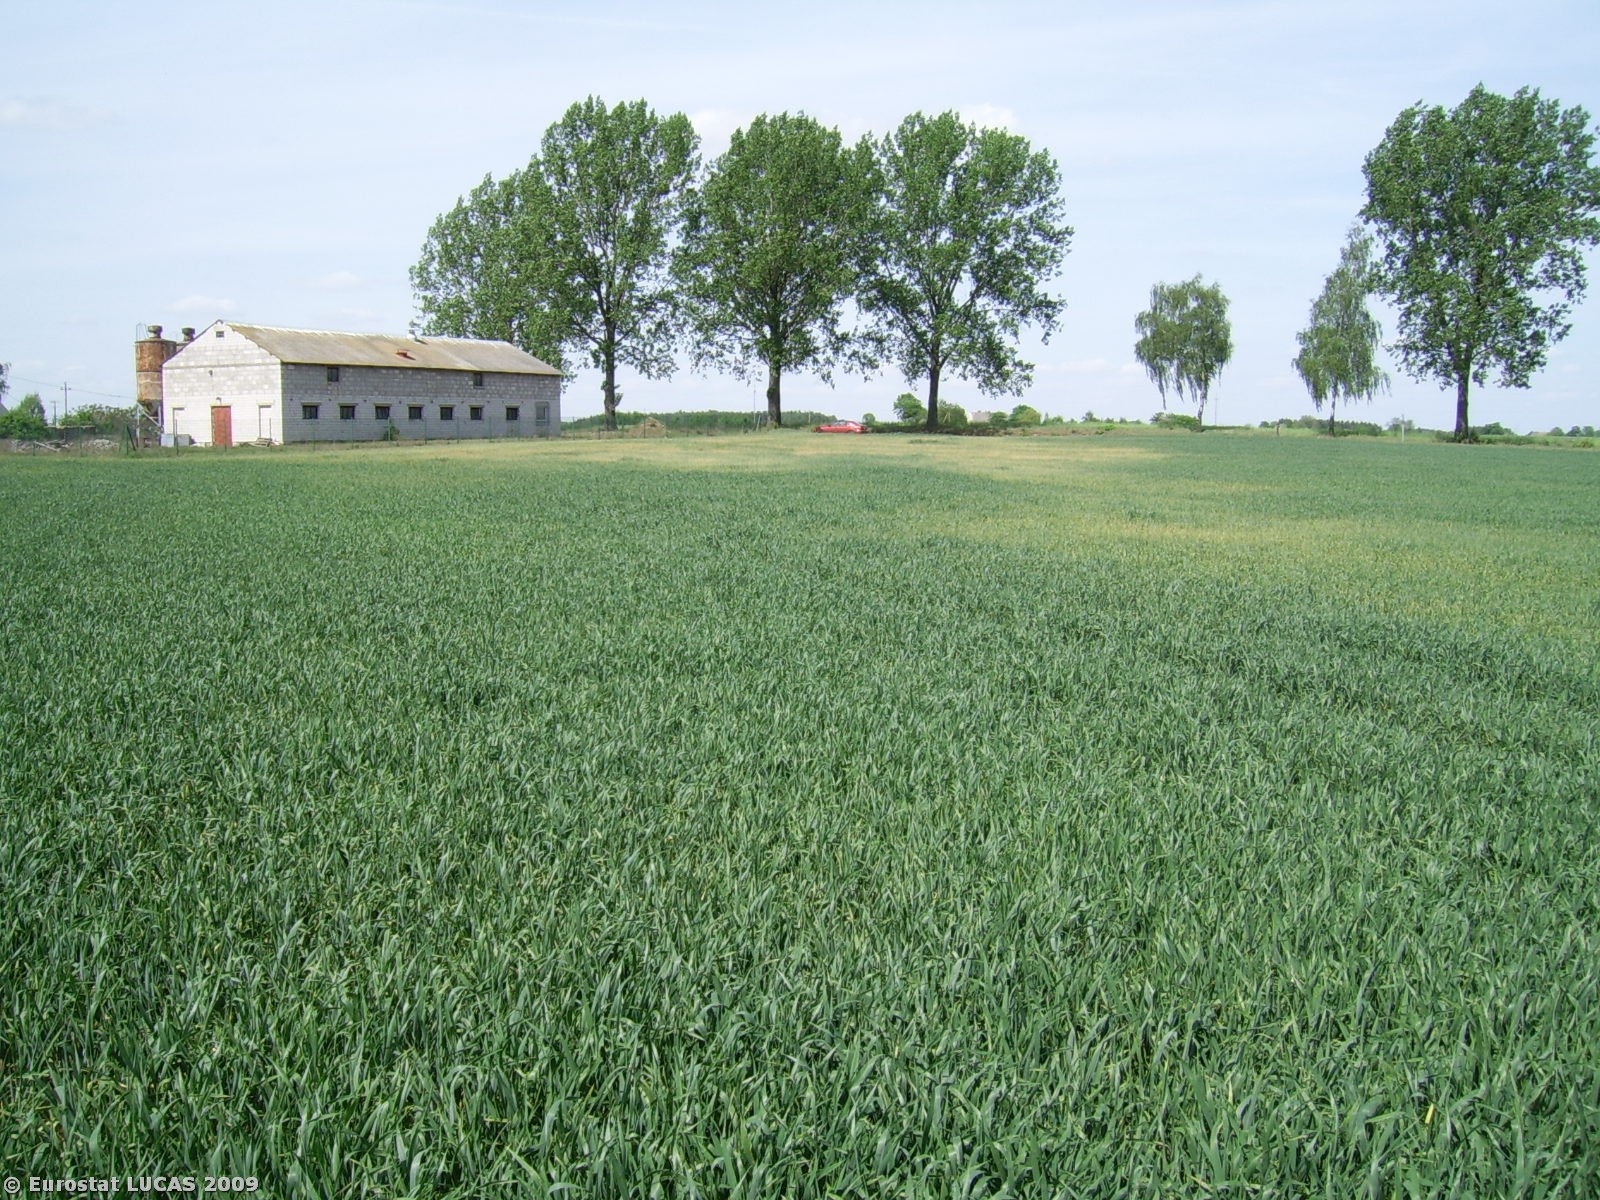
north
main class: Cropland
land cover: Common wheat
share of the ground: > 75 %
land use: Agriculture (excluding fallow land and kitchen gardens)
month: May
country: PL
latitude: 52.7290
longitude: 17.6094
